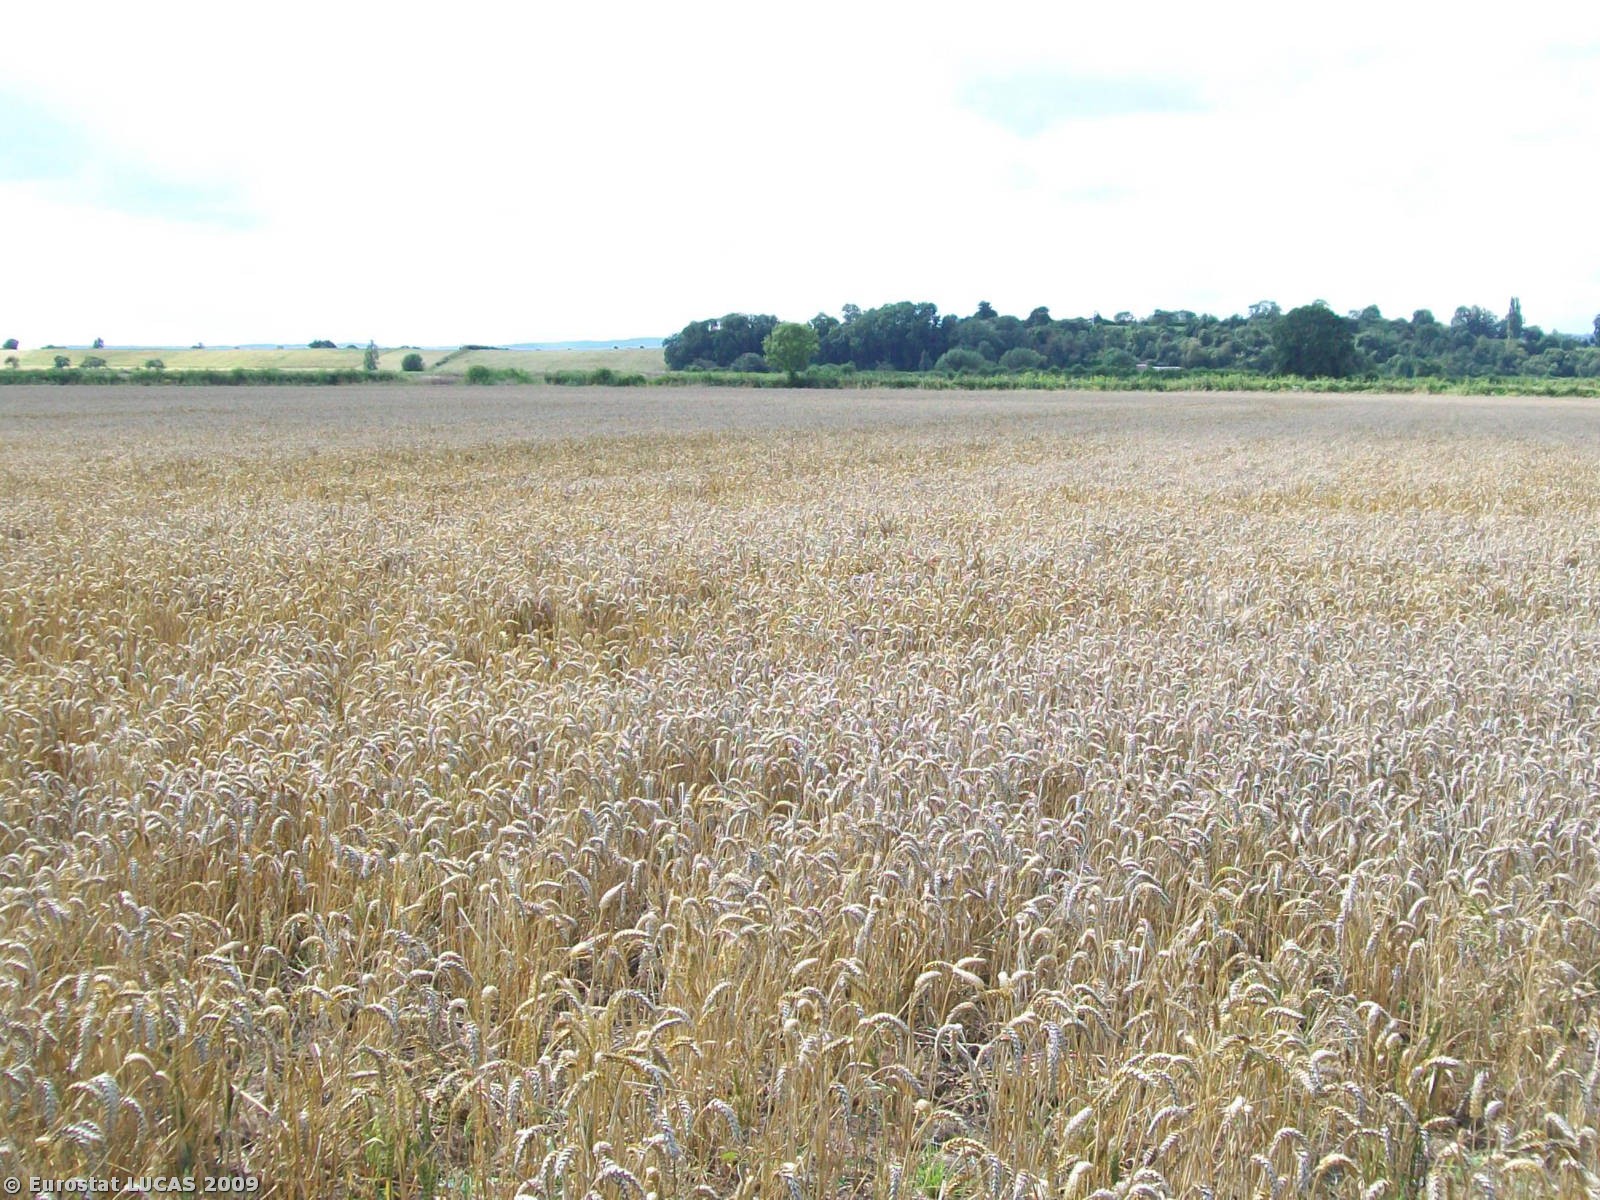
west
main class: Cropland
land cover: Common wheat
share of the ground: > 75 %
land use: Agriculture (excluding fallow land and kitchen gardens)
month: August
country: GB
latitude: 51.8203
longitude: -2.3520
